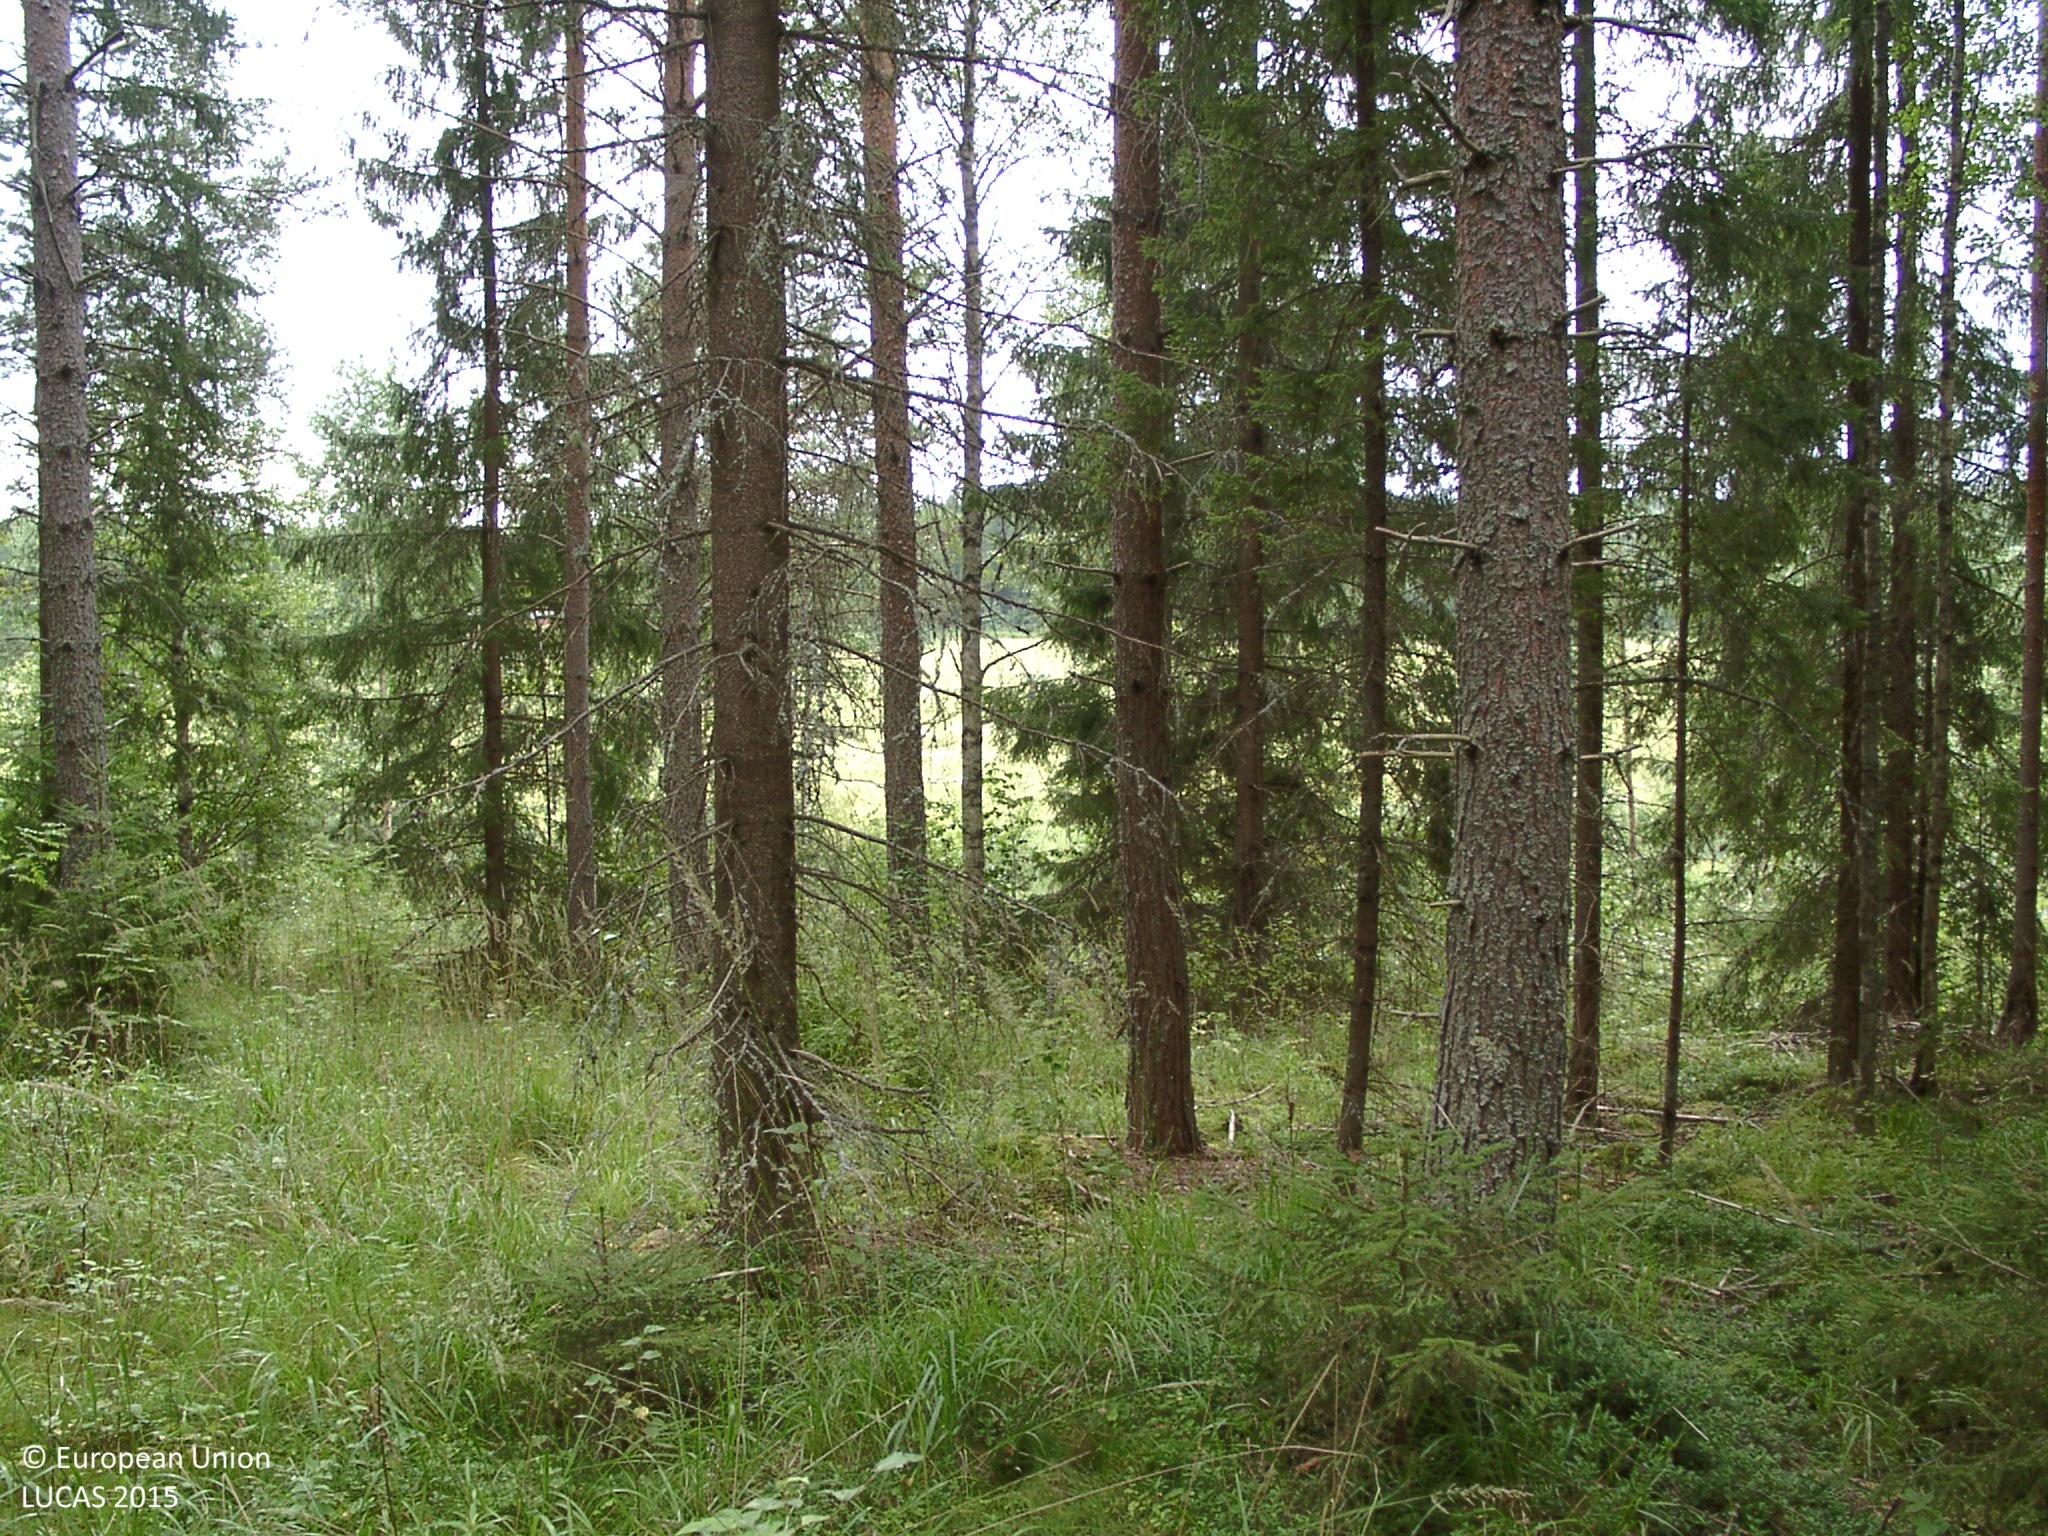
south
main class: Woodland
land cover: Other coniferous woodland
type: boreal forest
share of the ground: > 75 %
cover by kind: coniferous forest trees 60 %, broadleaved forest trees 15 %, lichens and mosses 10 %, unconsolidated bare surface 10 %, shrubs 5 %
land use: Forestry
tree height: > 5 m
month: August
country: FI
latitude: 61.8175
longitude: 25.3561
